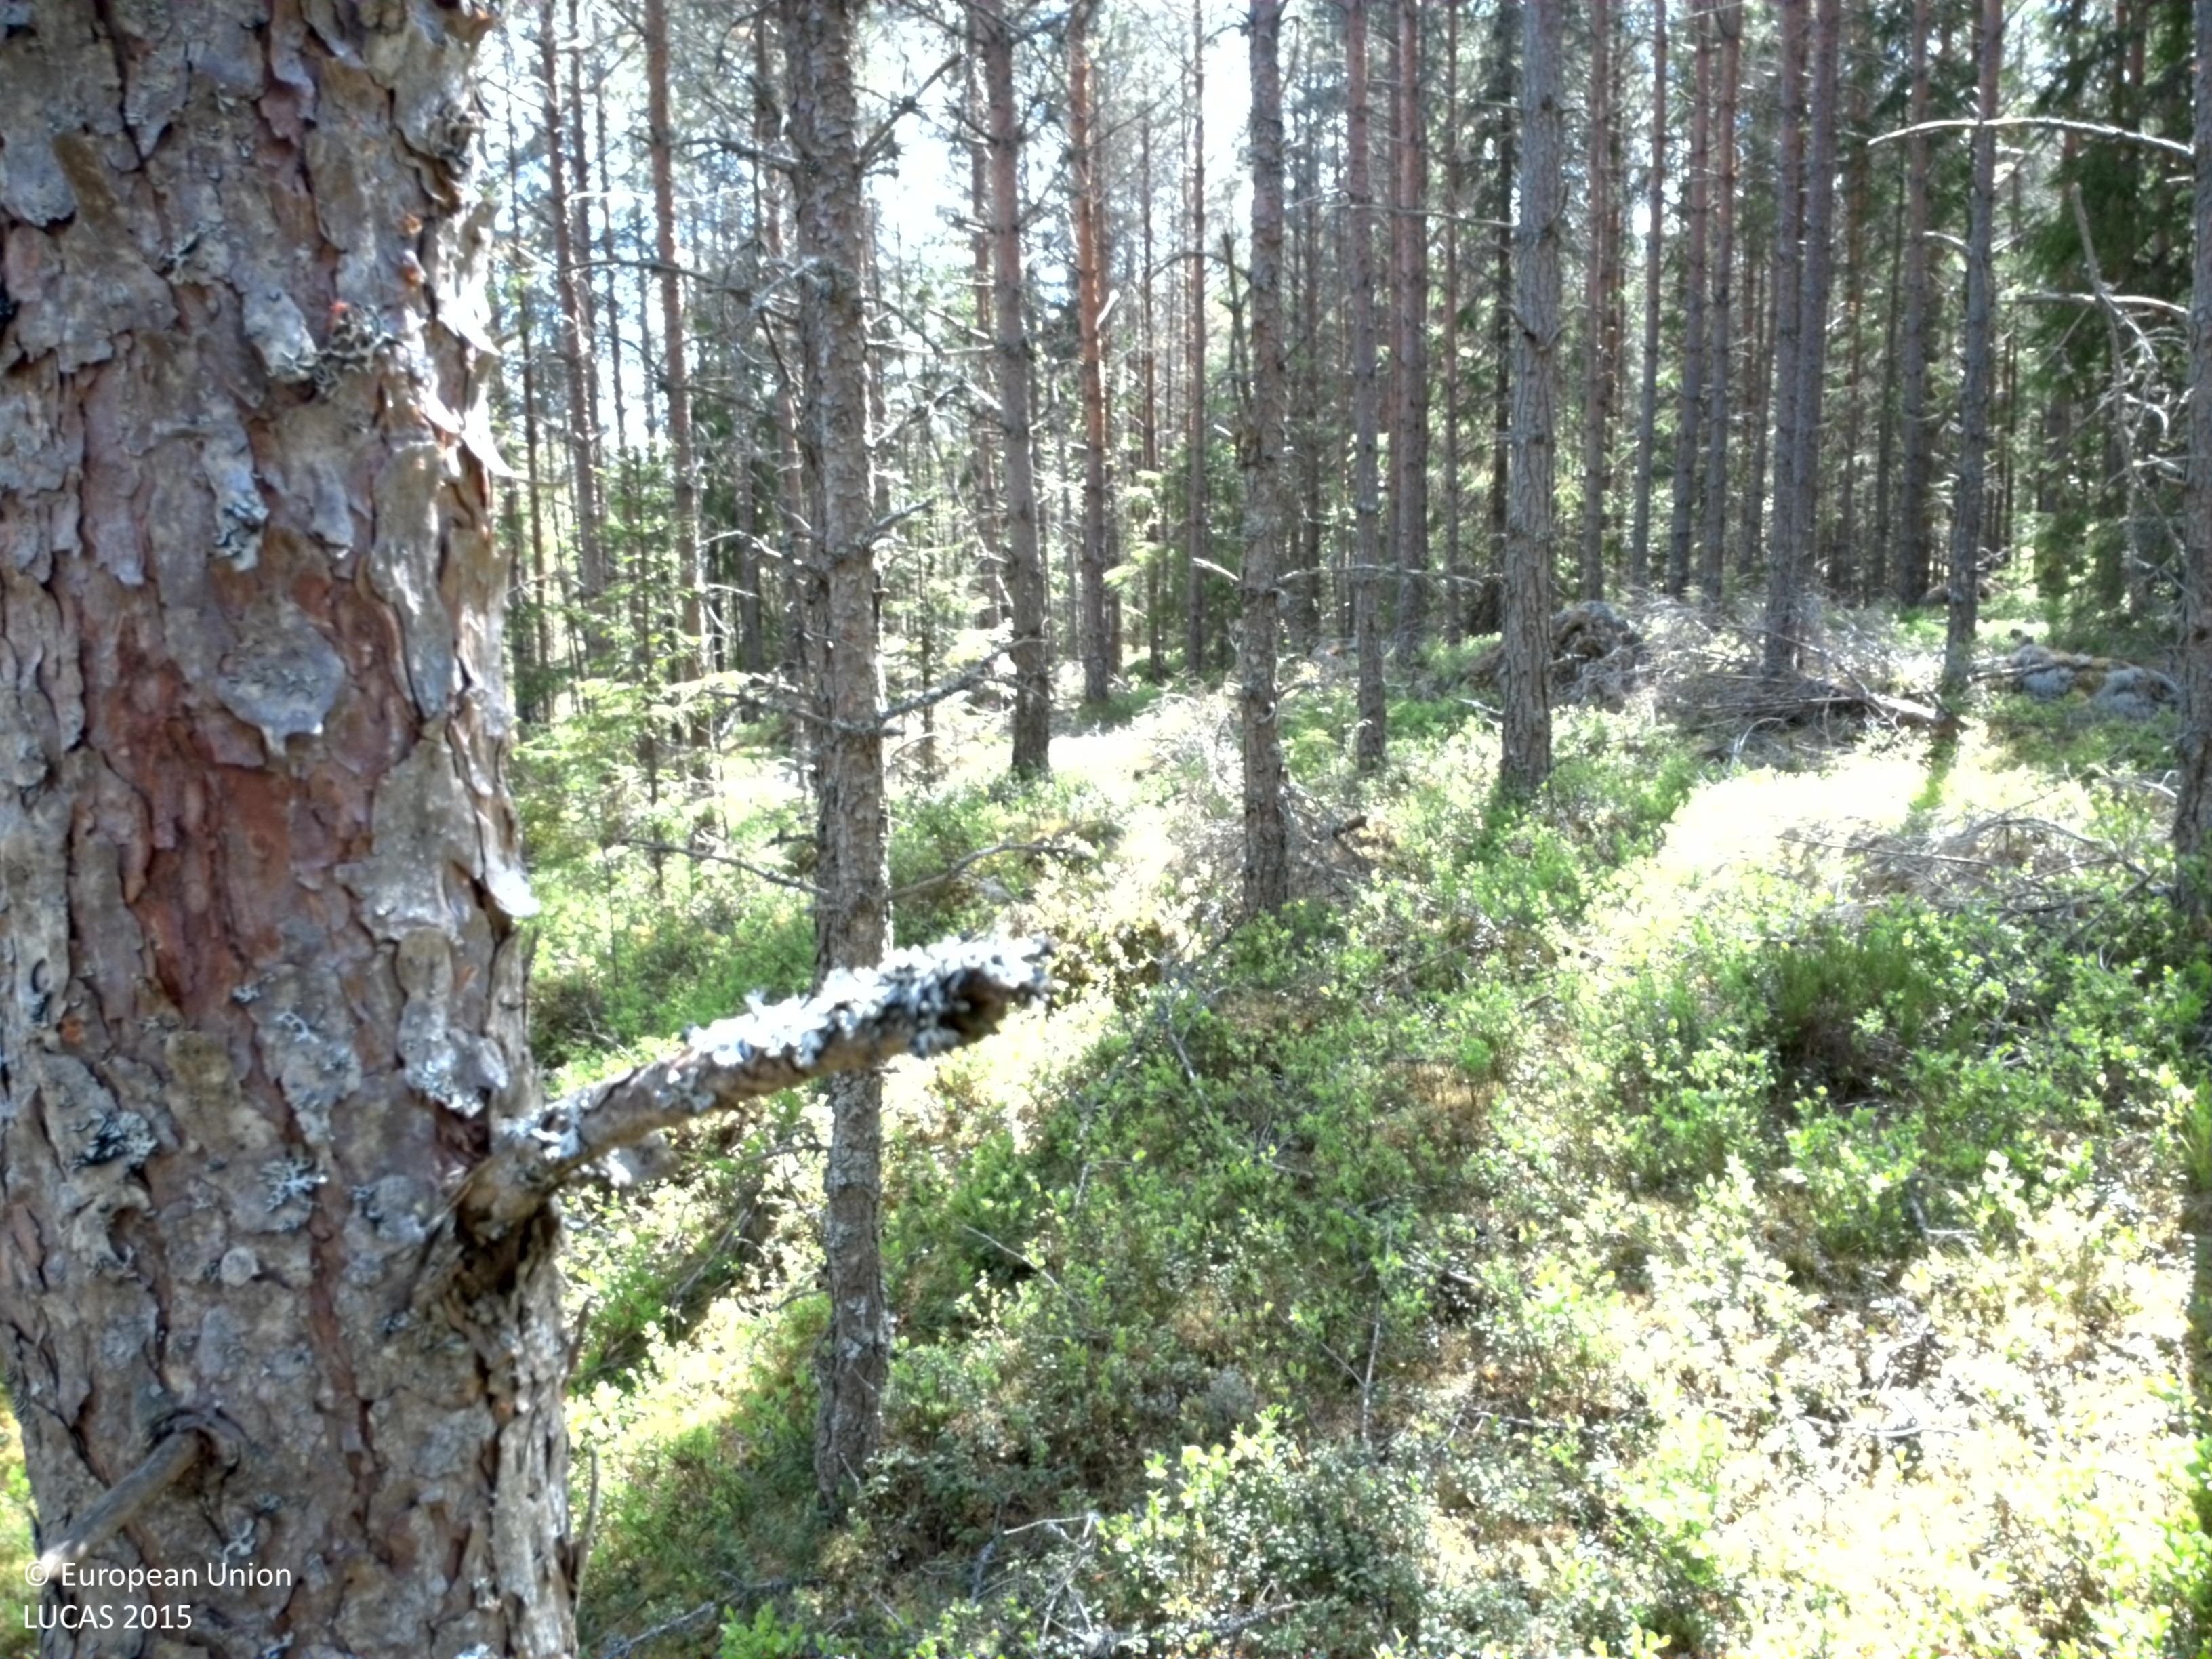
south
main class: Woodland
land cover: Pine dominated coniferous woodland
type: boreal forest
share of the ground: > 75 %
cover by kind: coniferous forest trees 80 %, shrubs 10 %, lichens and mosses 10 %
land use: Forestry
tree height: > 5 m
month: June
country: SE
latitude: 59.3679
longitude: 12.4046
